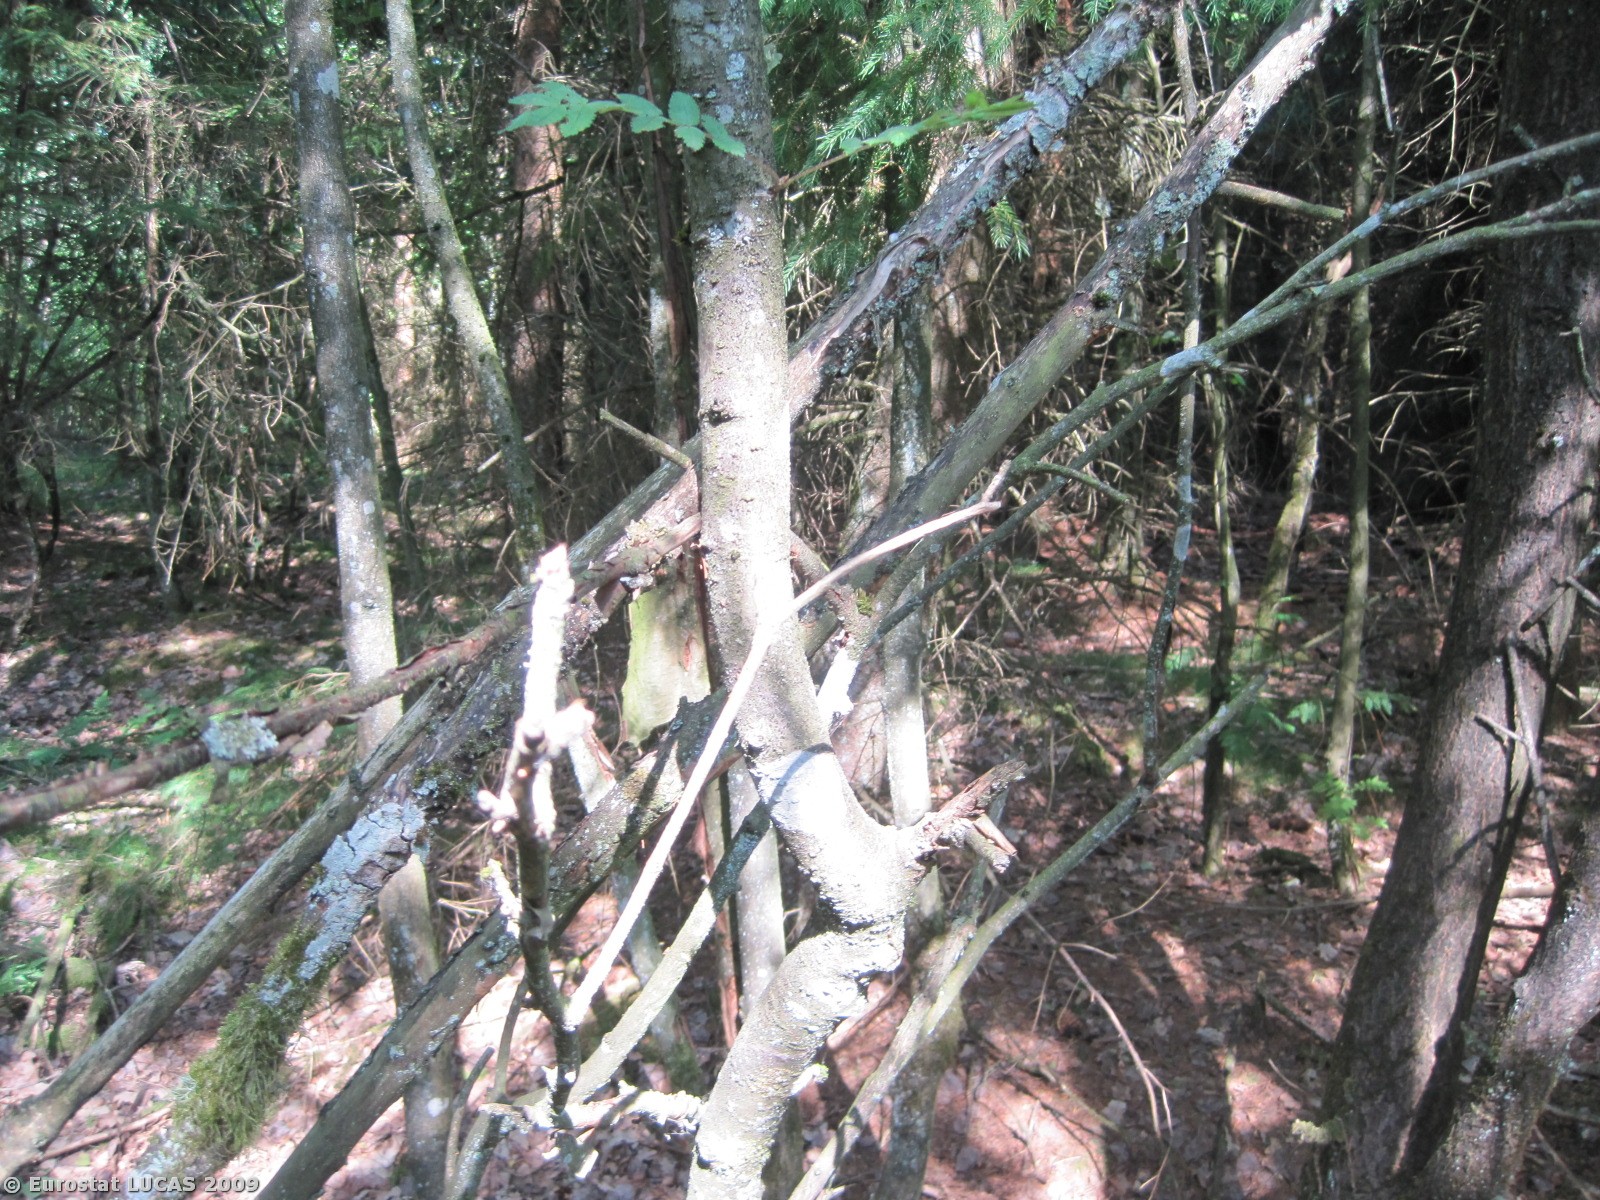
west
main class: Woodland
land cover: Mixed woodland
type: plantations and self-sown exotic forest
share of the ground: > 75 %
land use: Forestry
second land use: Amenities, museums, leisure
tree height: > 5 m
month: June
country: DK
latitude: 56.3085
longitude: 8.8537
